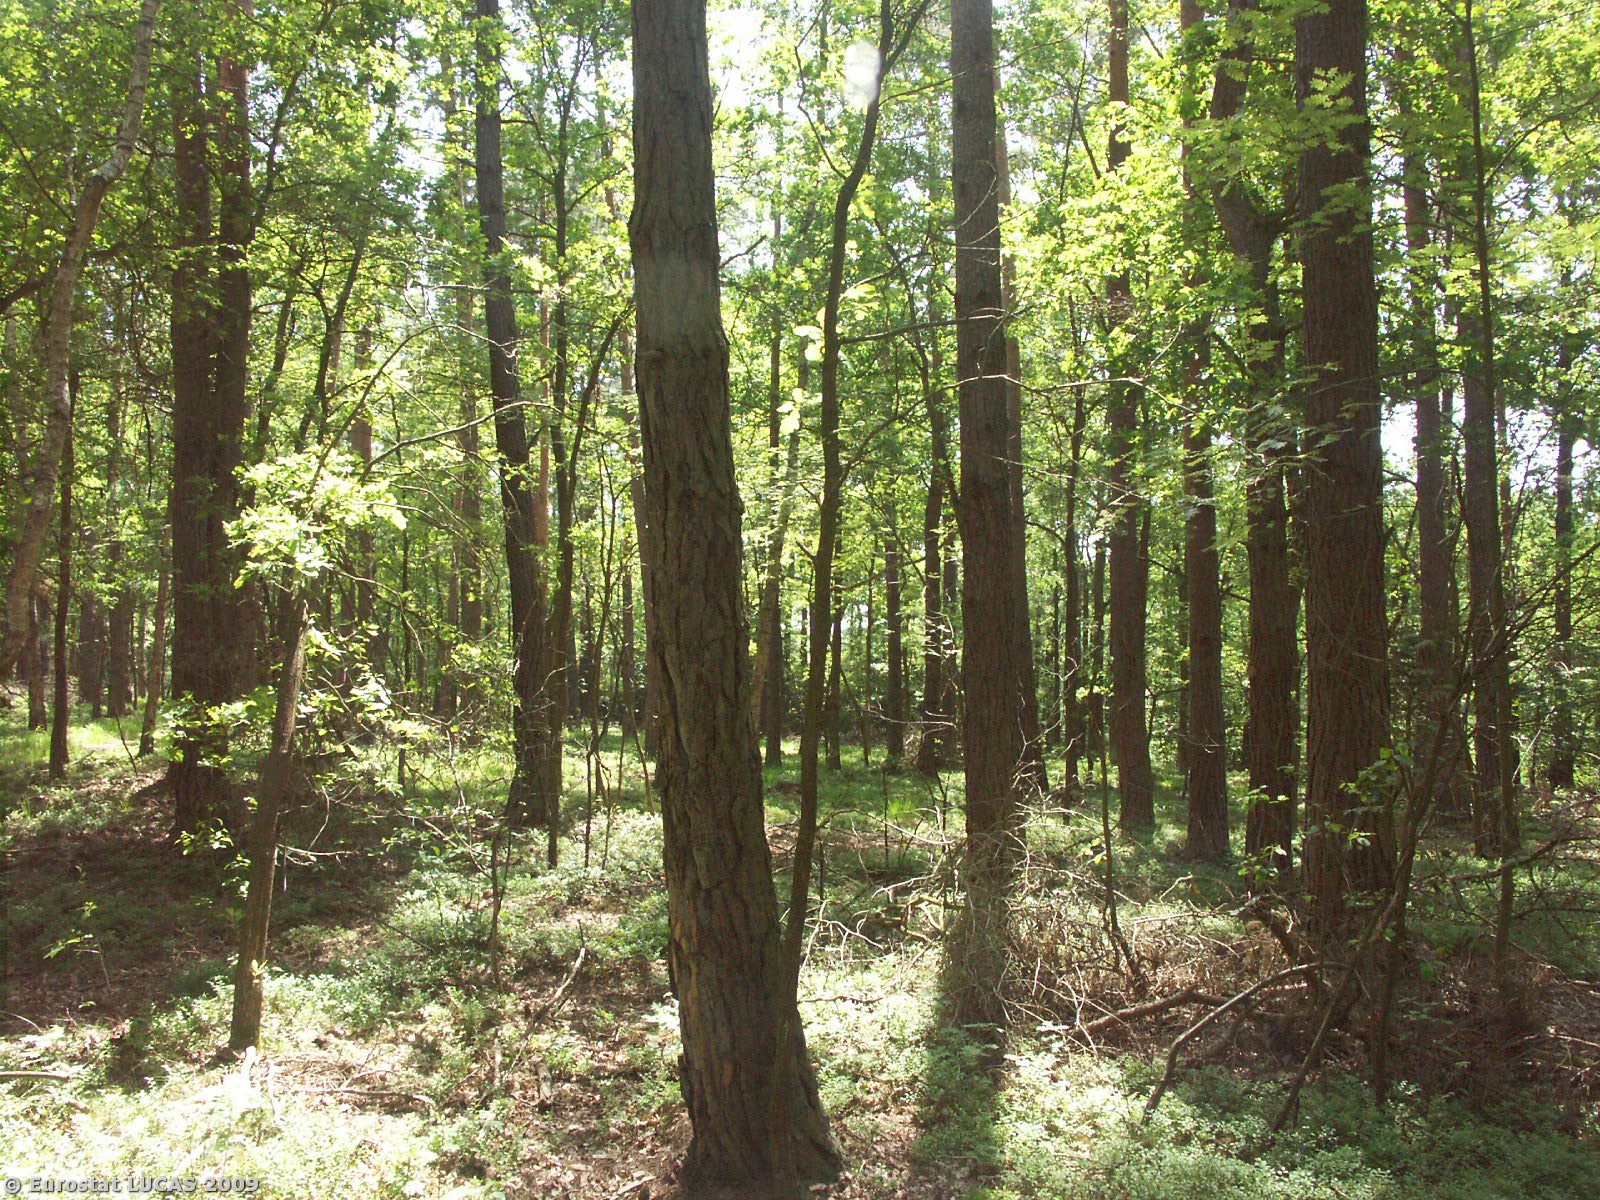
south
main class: Woodland
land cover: Mixed woodland
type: hemiboreal forest and nemoral coniferous forest and mixed broadleaved-coniferous forest
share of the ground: > 75 %
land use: Forestry
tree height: > 5 m
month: May
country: CZ
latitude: 49.0259
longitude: 14.6650
